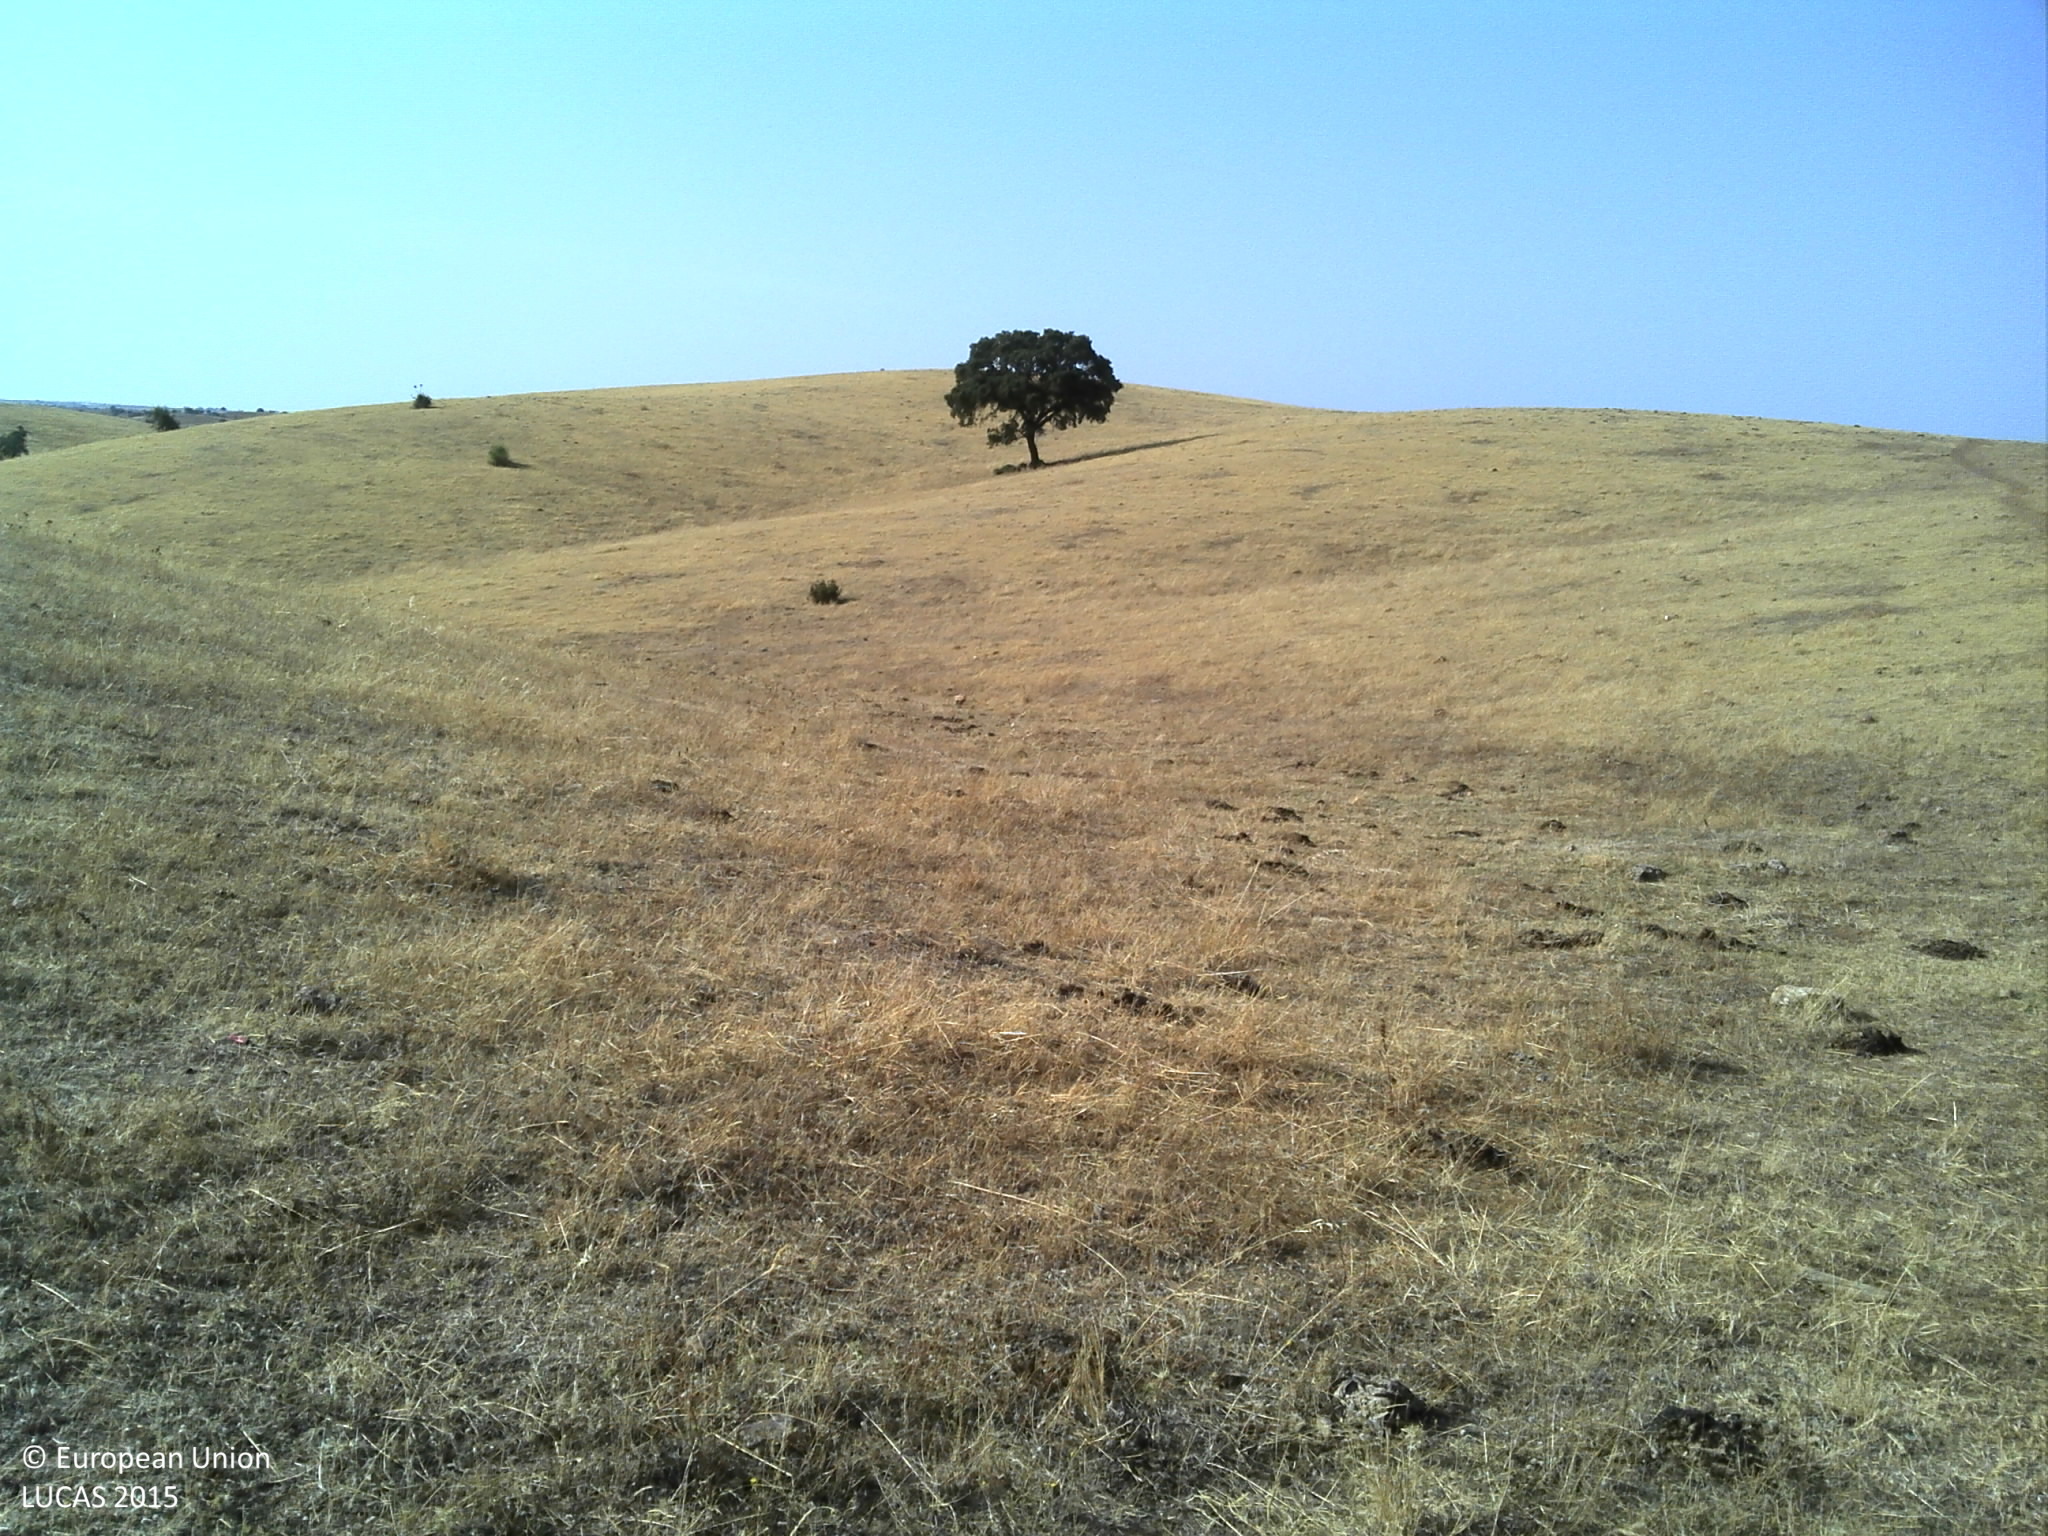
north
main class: Grassland
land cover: Grassland without tree/shrub cover
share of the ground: 10 - 25 %
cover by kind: unconsolidated bare surface 85 %, herbaceous plants 15 %
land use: Agriculture (excluding fallow land and kitchen gardens)
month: July
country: PT
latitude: 37.8292
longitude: -7.8036
